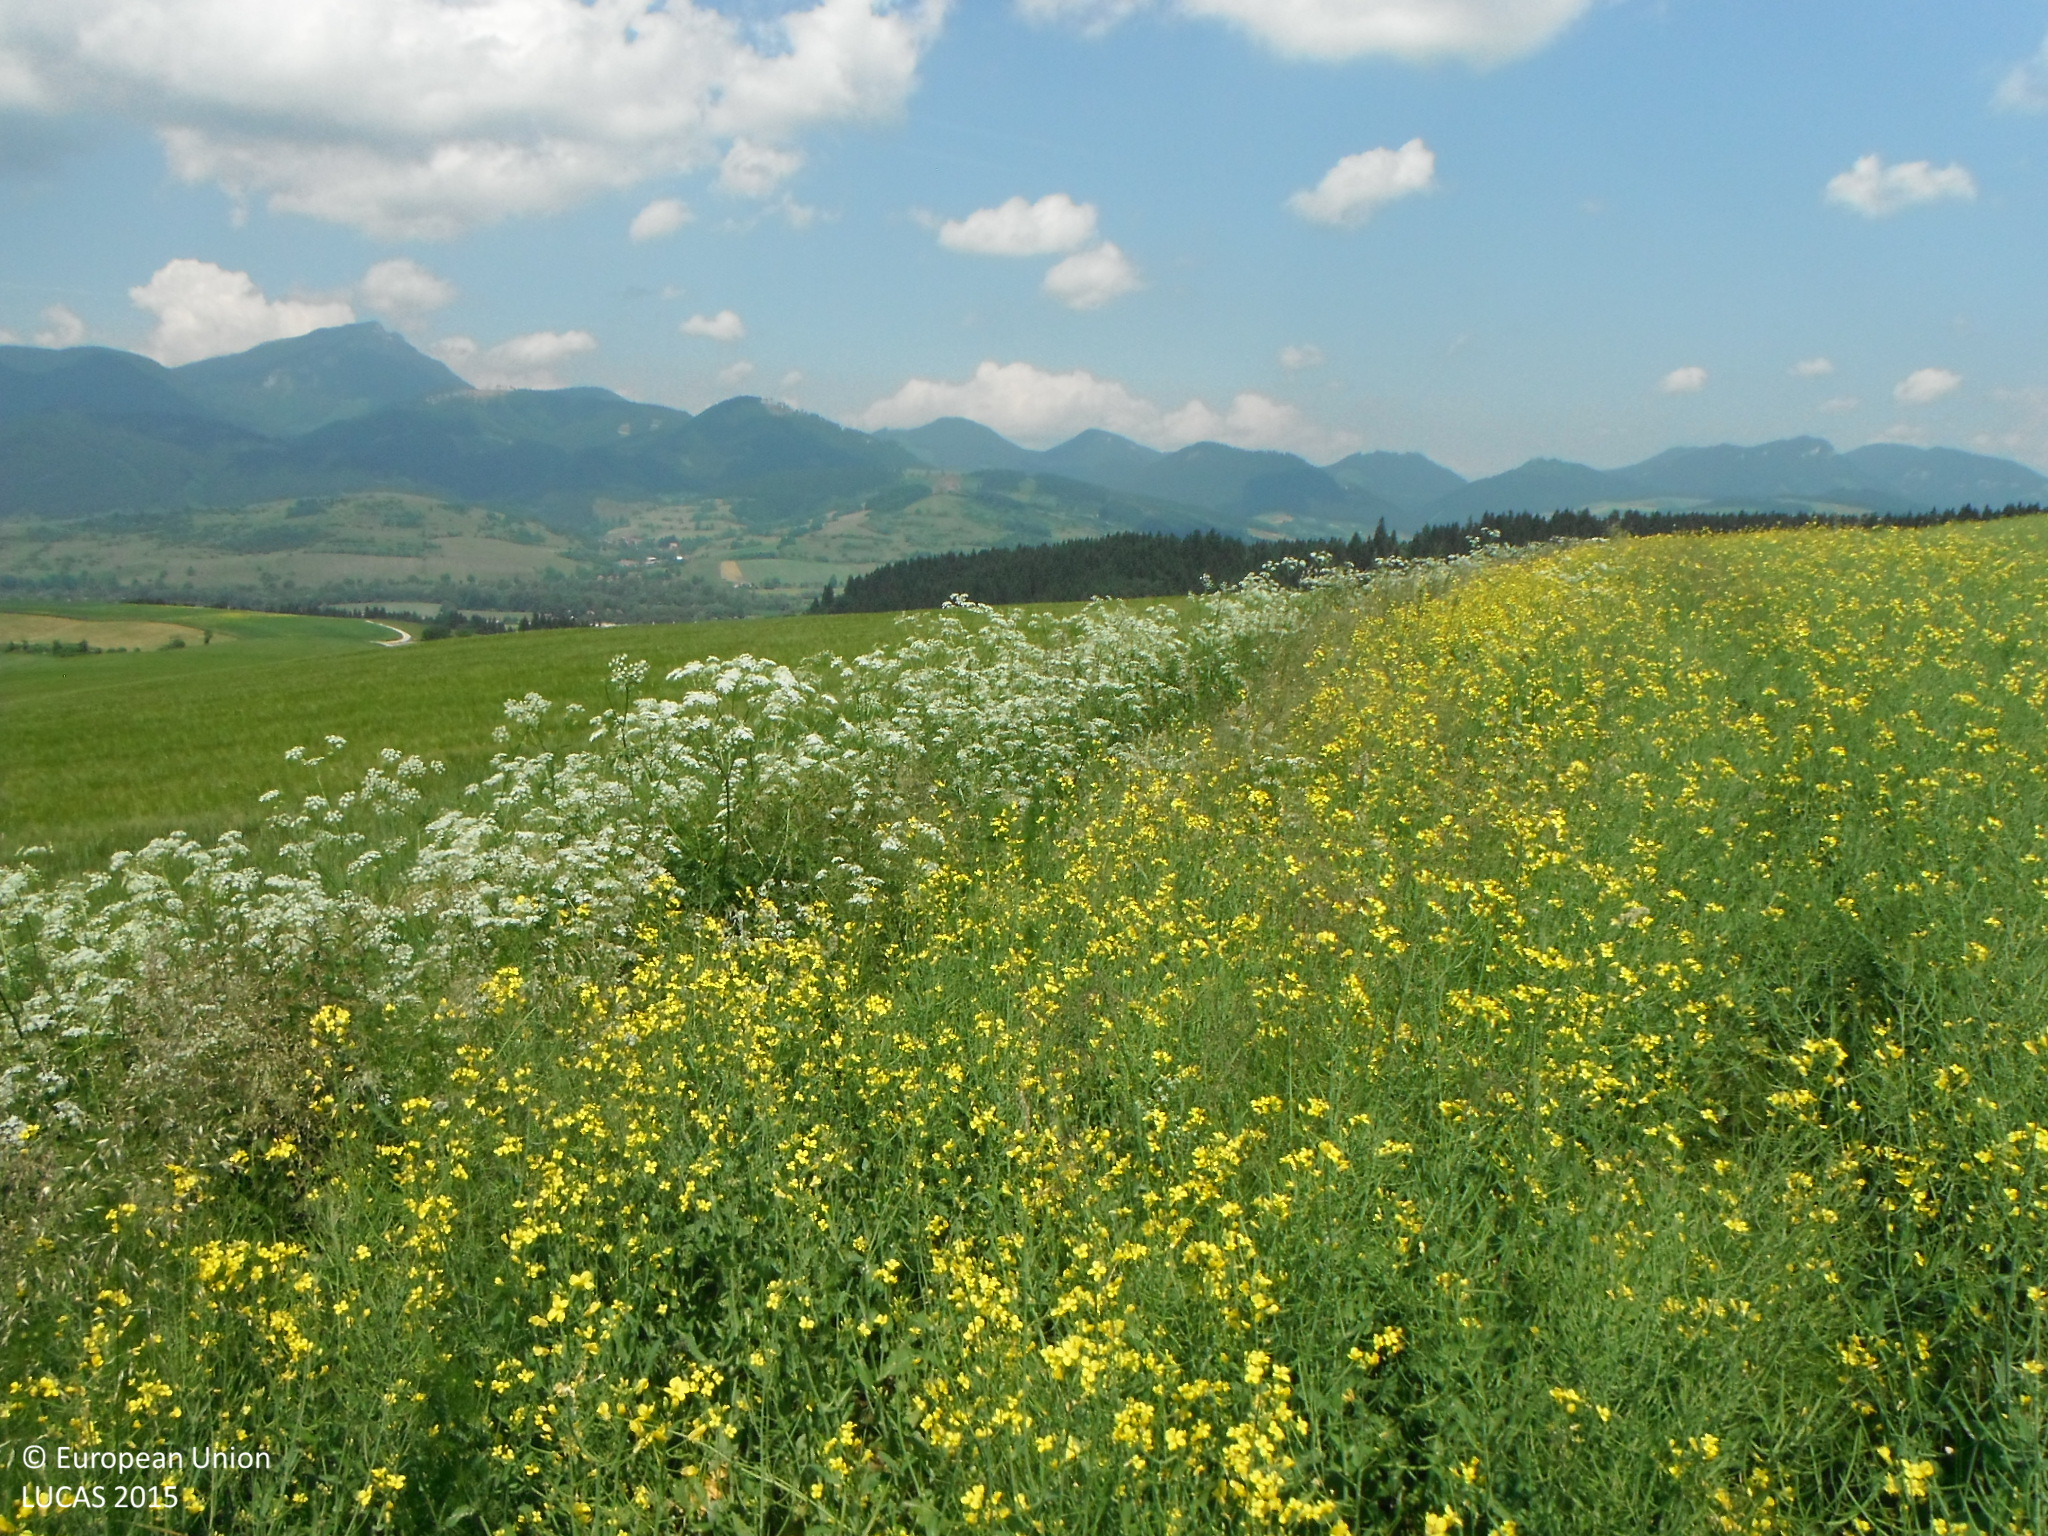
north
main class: Cropland
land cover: Rape and turnip rape
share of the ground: > 75 %
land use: Agriculture (excluding fallow land and kitchen gardens)
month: June
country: SK
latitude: 49.0707
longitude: 19.4016
